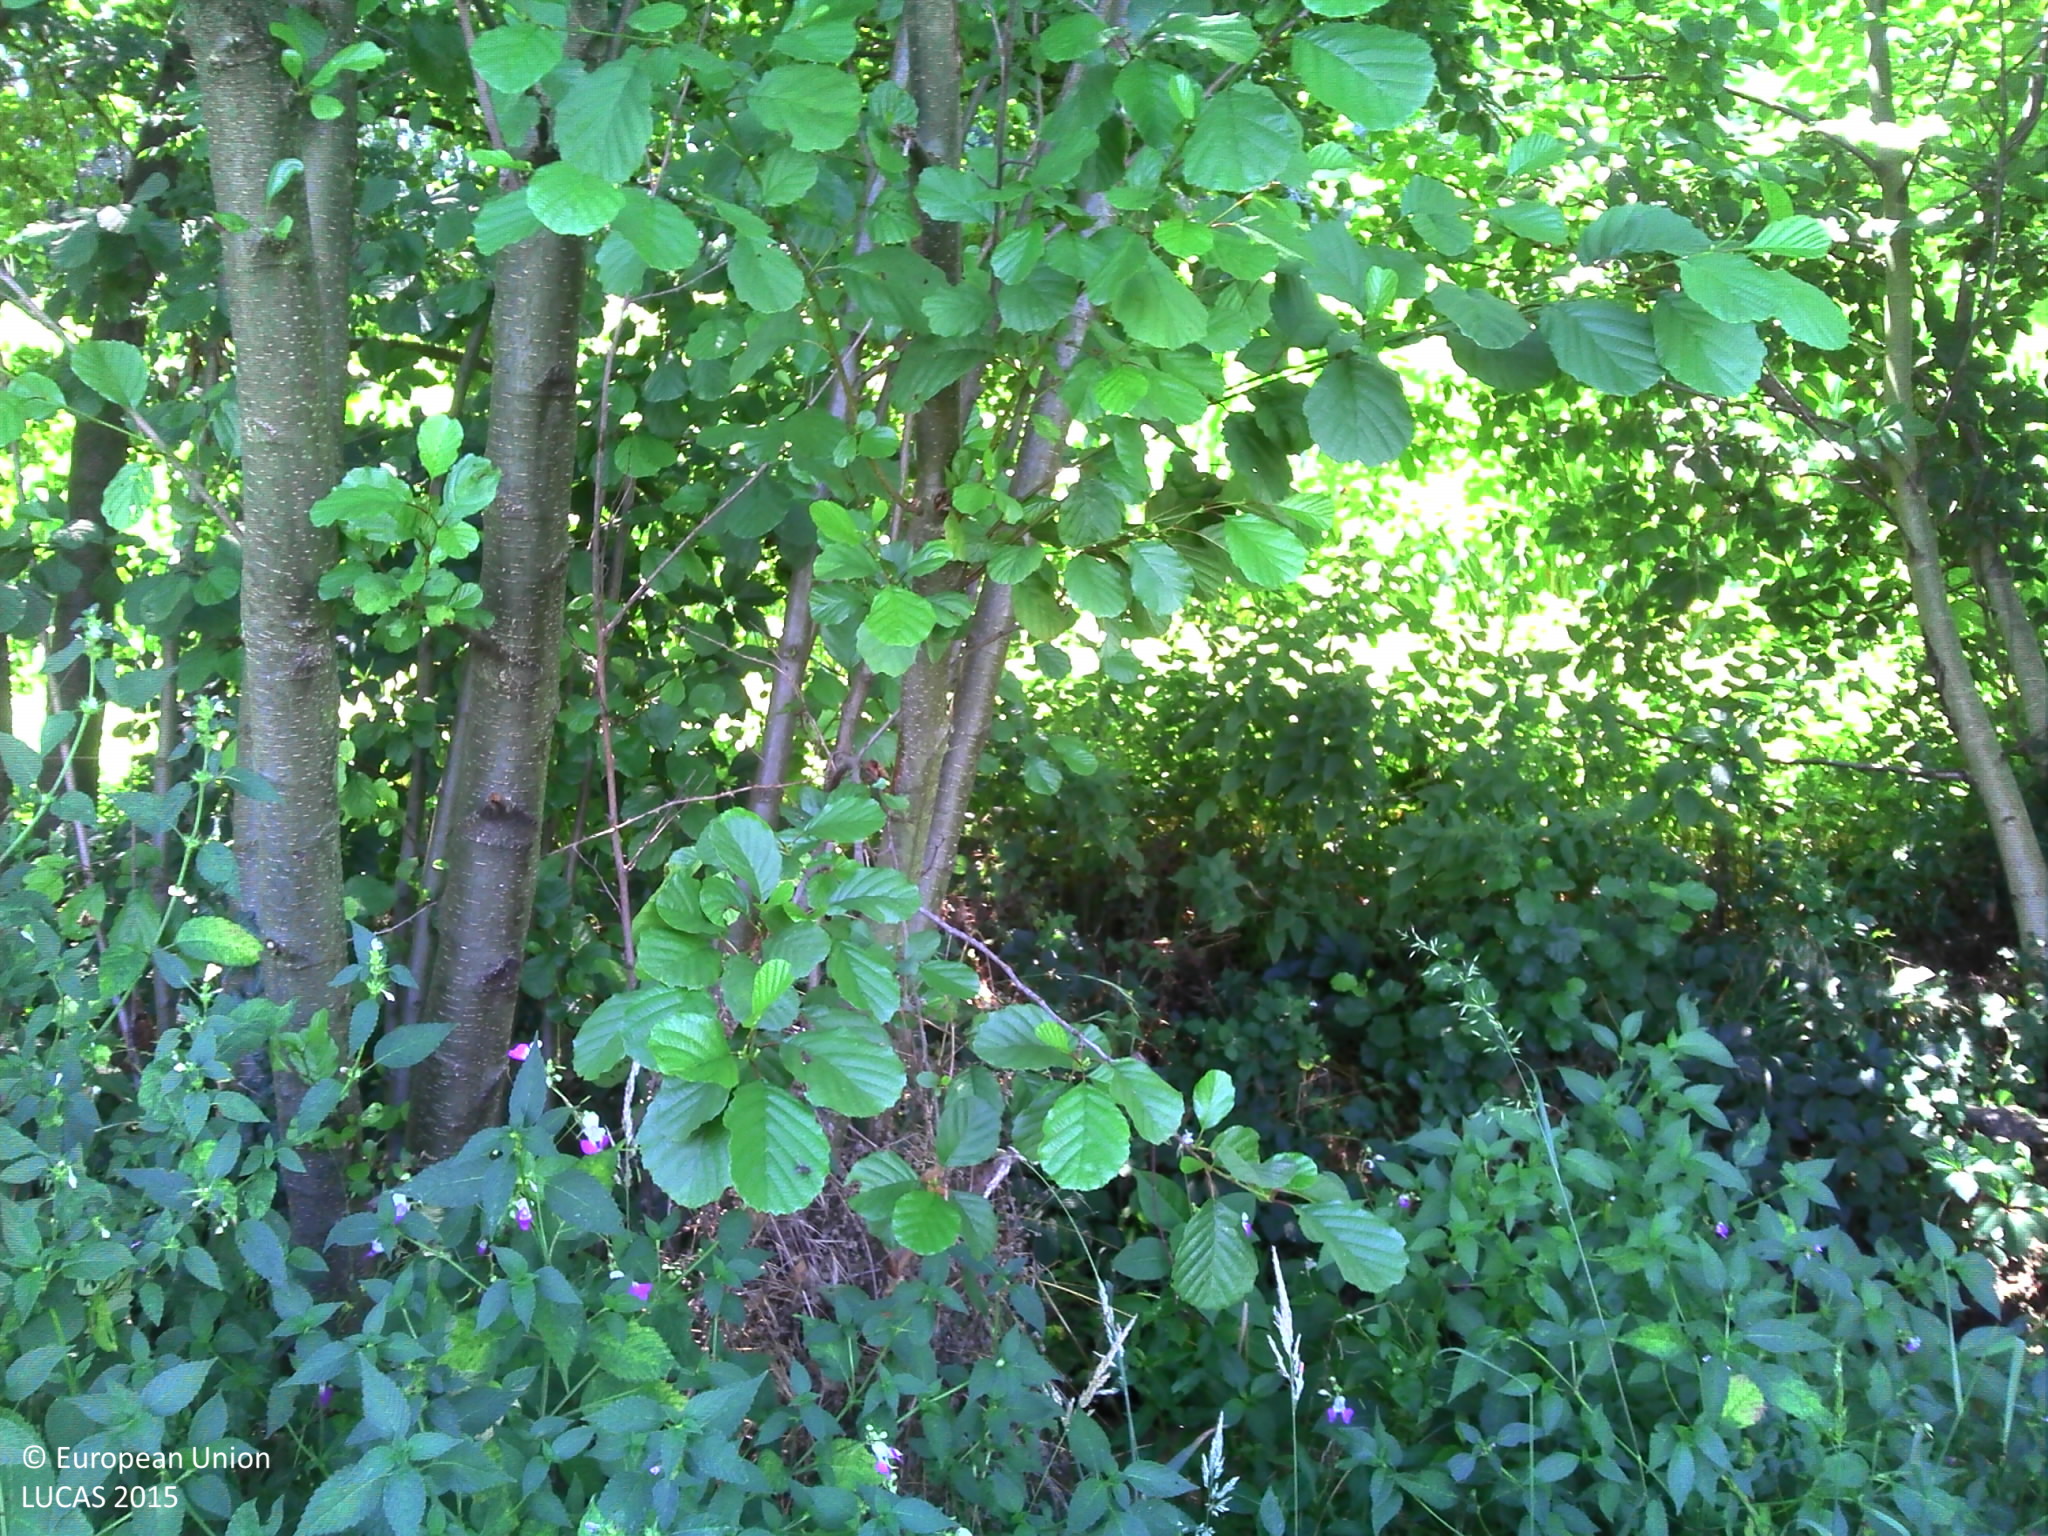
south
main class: Woodland
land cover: Broadleaved woodland
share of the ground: > 75 %
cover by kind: broadleaved forest trees 80 %, herbaceous plants 20 %
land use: Semi-natural and natural areas not in use
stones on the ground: < 10 %
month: July
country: FR
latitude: 45.3265
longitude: 4.8885
